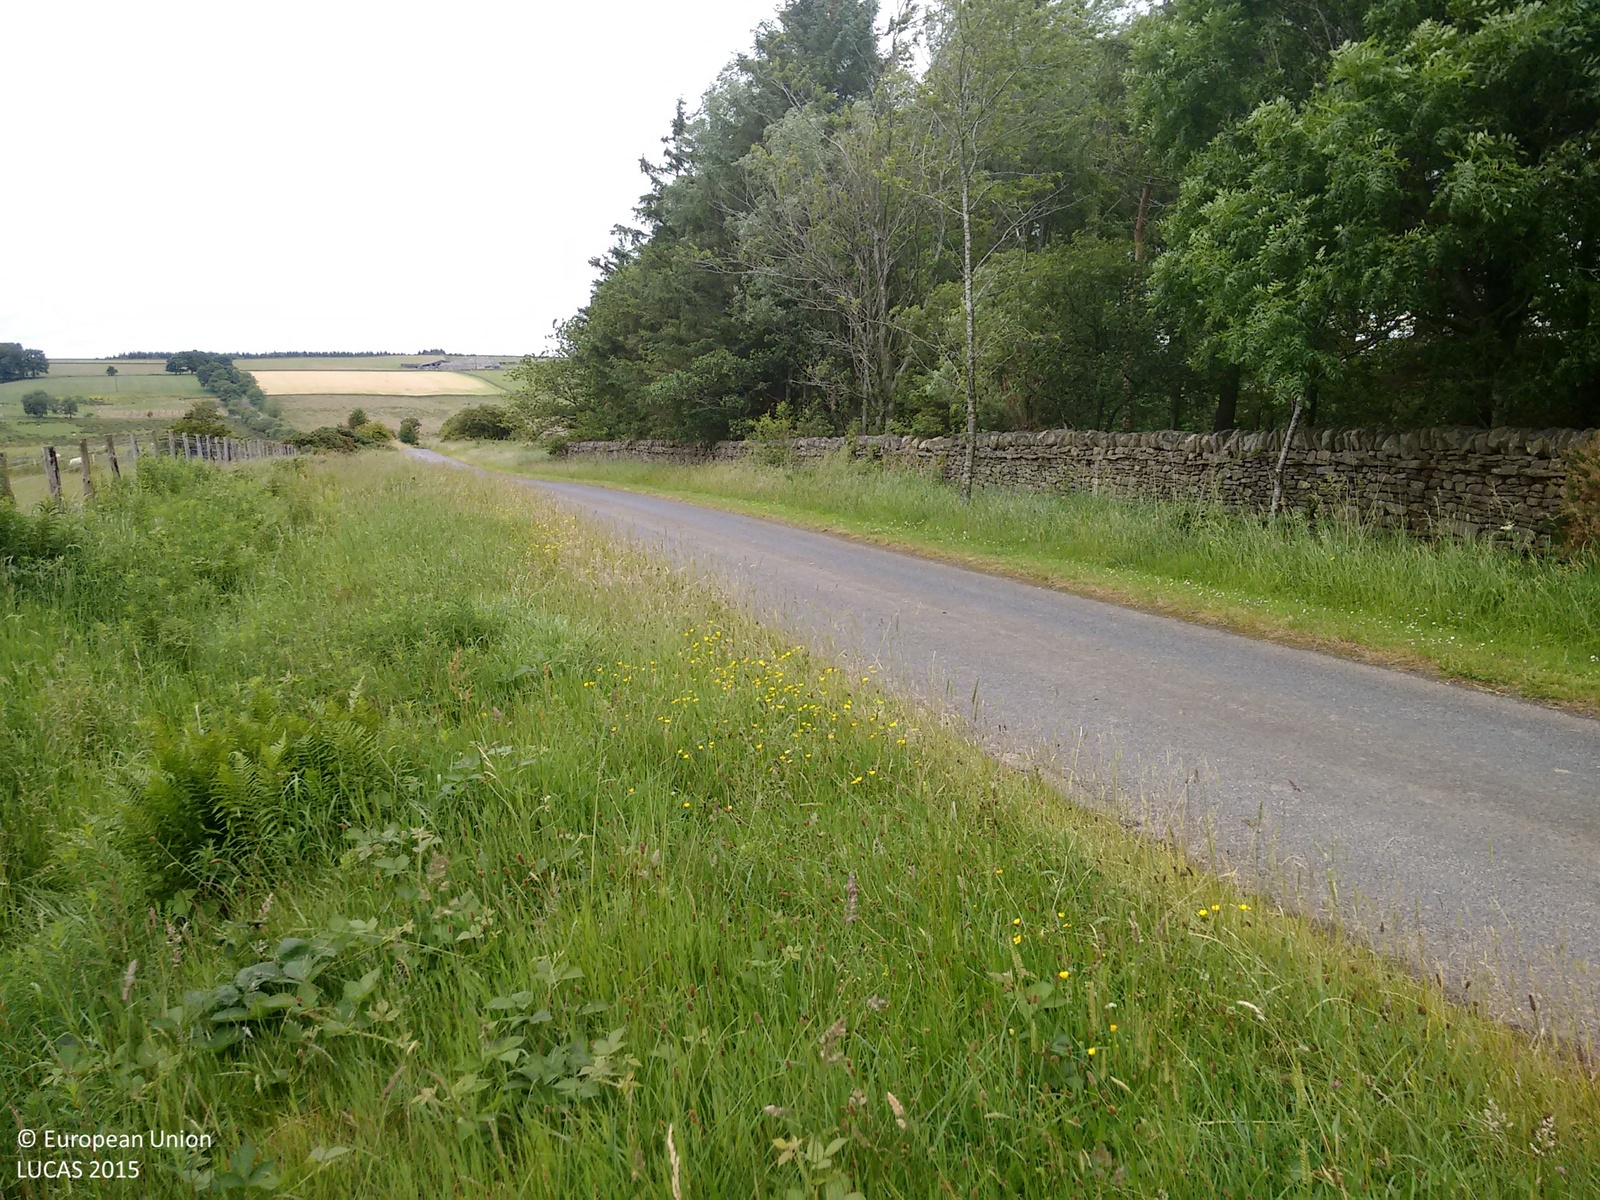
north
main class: Grassland
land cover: Grassland without tree/shrub cover
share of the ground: > 75 %
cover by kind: herbaceous plants 100 %
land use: Agriculture (excluding fallow land and kitchen gardens)
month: July
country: GB
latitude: 54.6513
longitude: -1.8791
